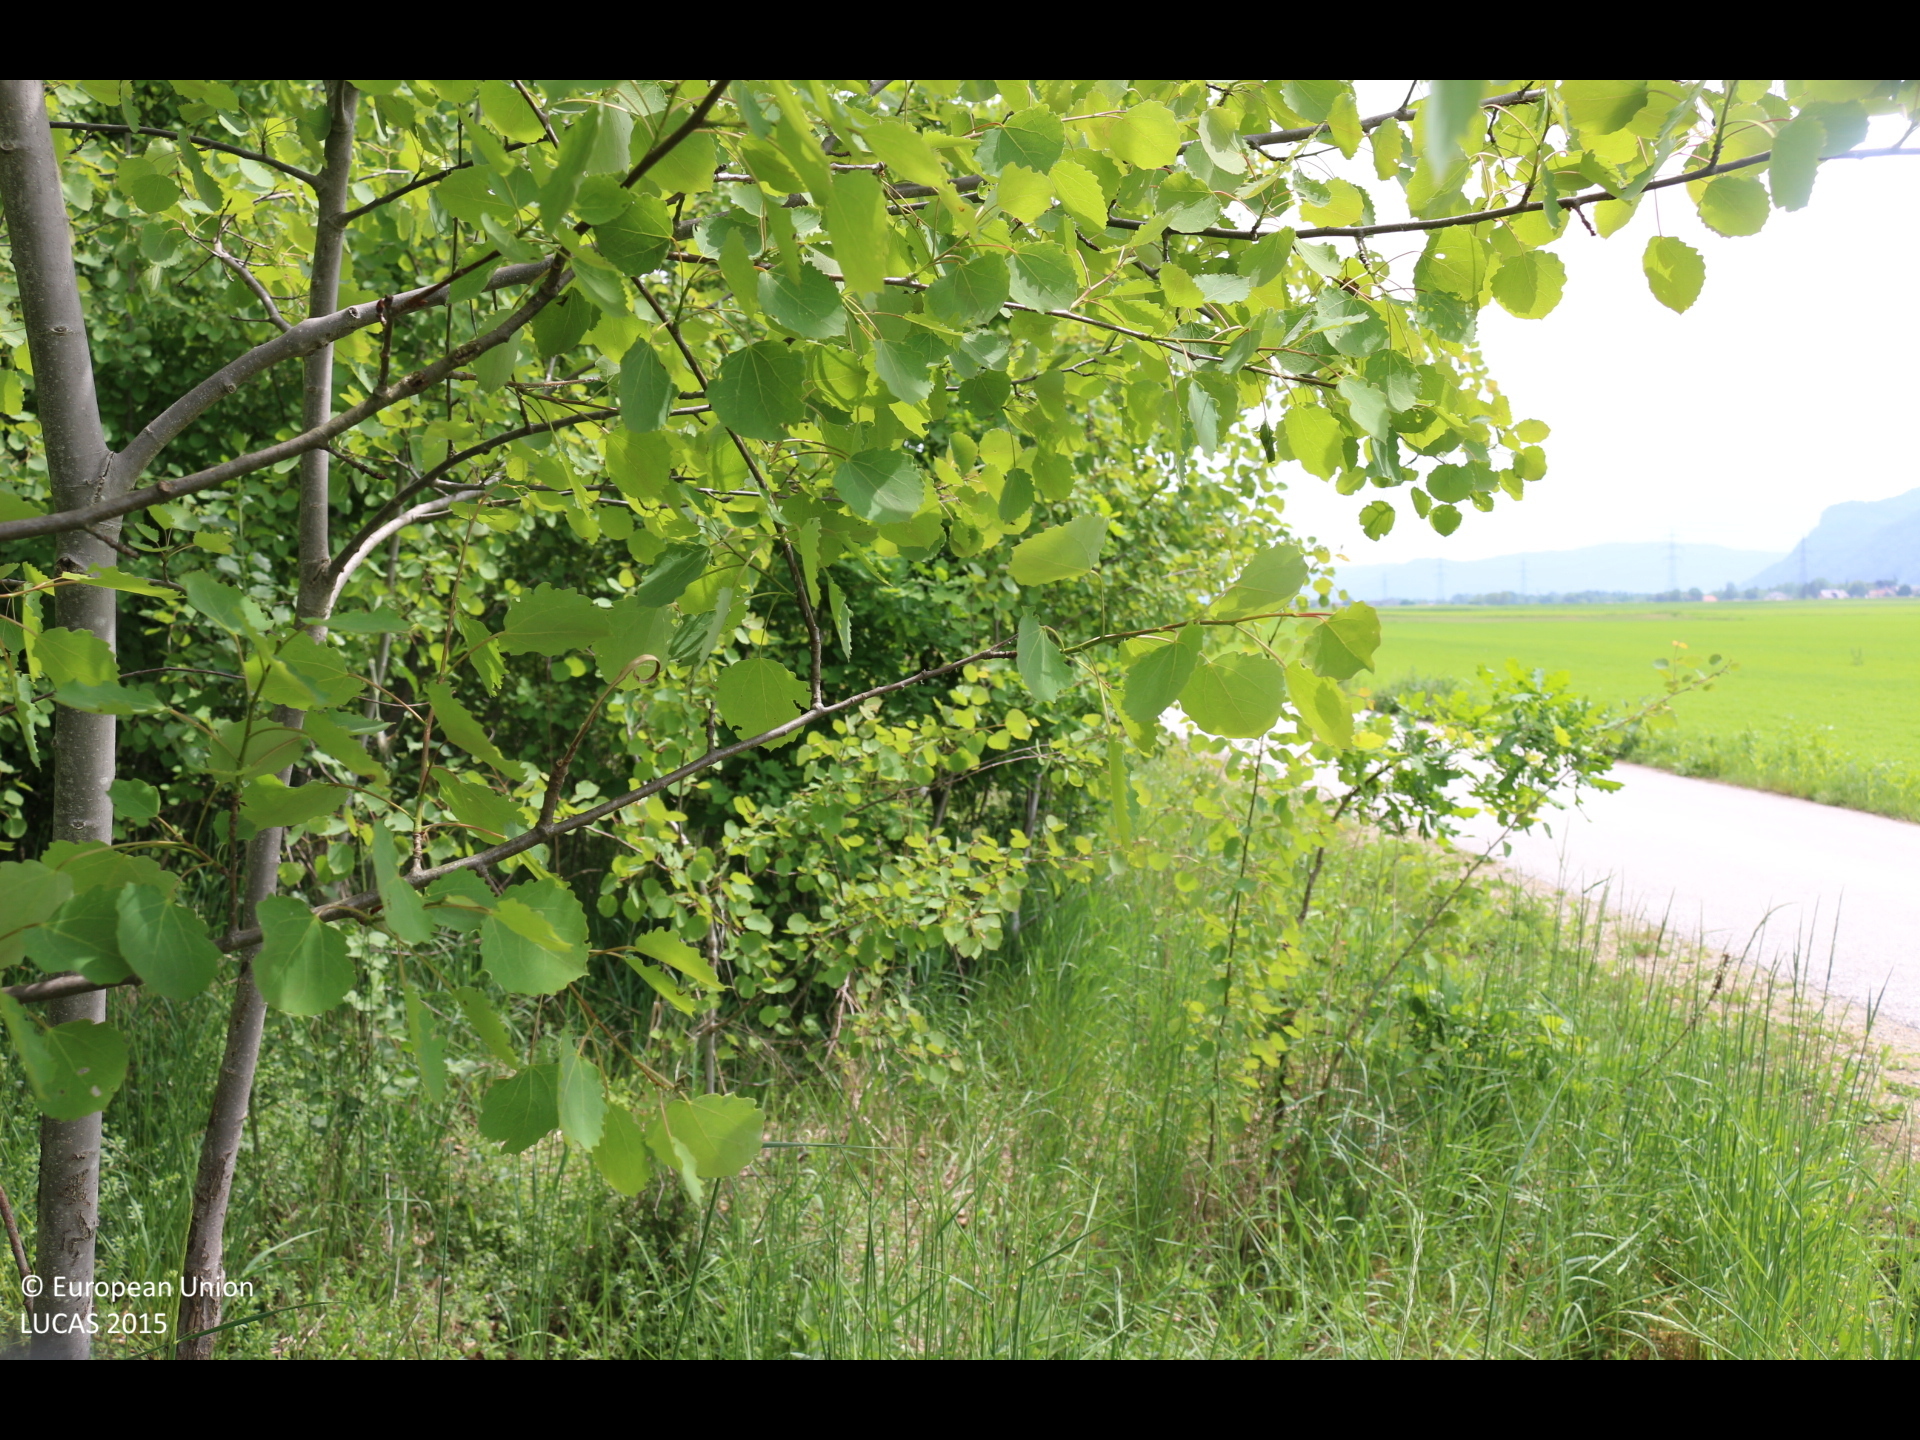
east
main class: Woodland
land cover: Broadleaved woodland
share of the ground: > 75 %
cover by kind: broadleaved forest trees 80 %, shrubs 10 %, herbaceous plants 10 %
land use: Railway transport
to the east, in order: Broadleaved woodland; Grass margins; Paved roads, cycling and walking lanes; Grass margins; Other fibre and oleaginous crops; Electric lines; Soya; Tracks; Maize
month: May
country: AT
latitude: 46.6204
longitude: 14.4246
